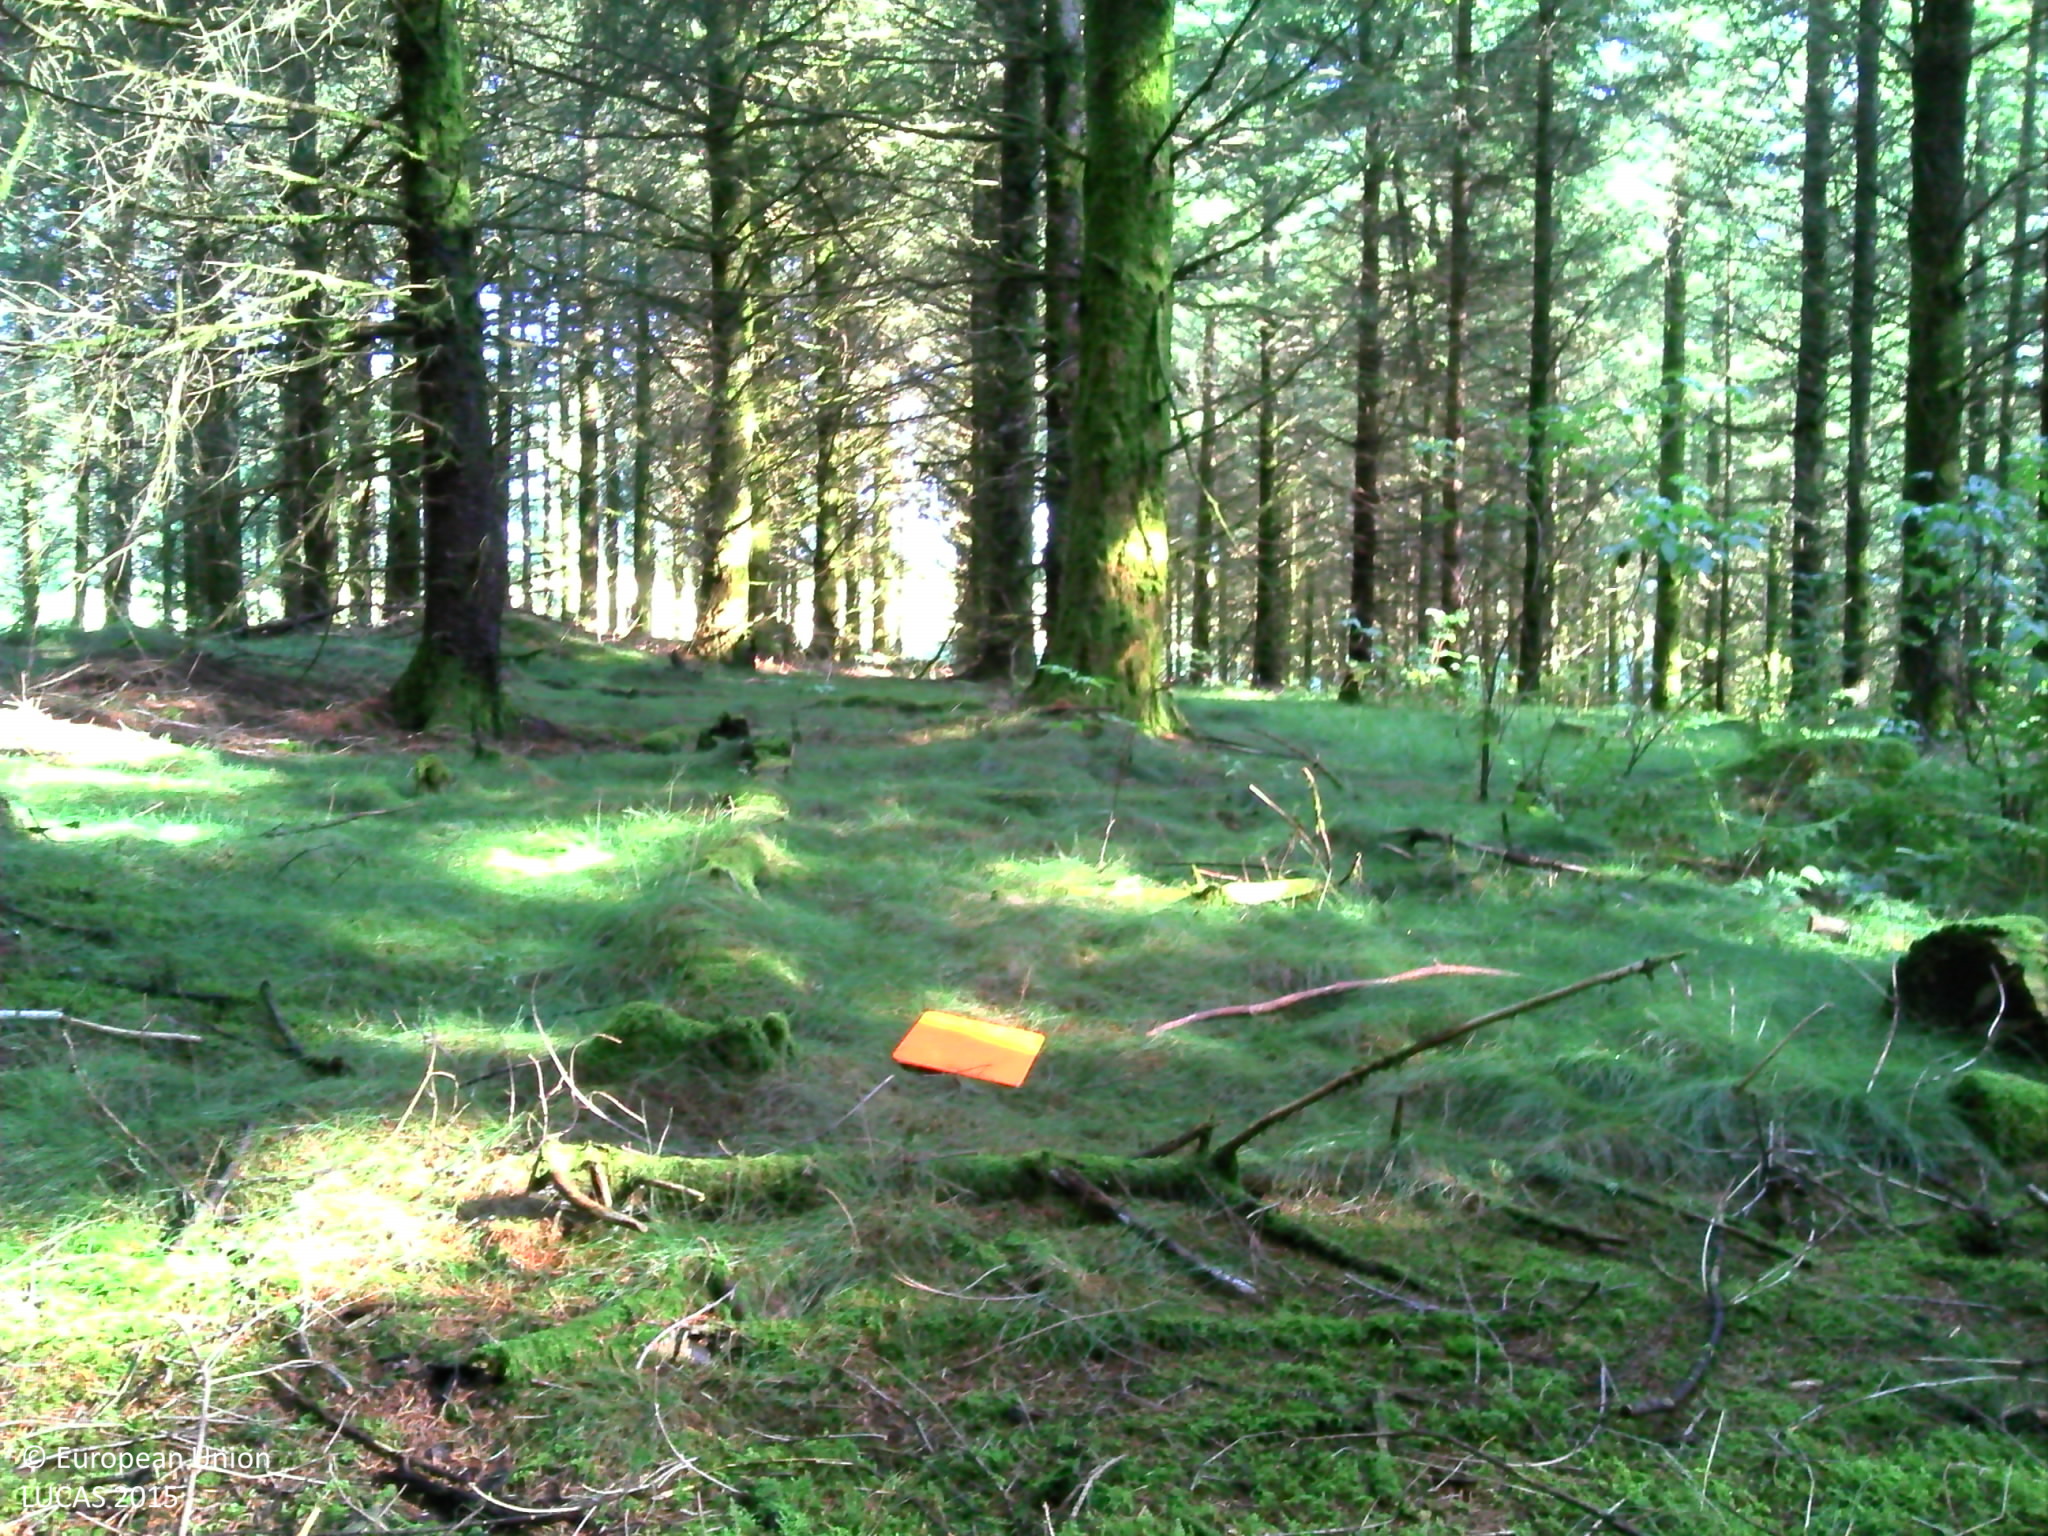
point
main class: Woodland
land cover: Spruce dominated coniferous woodland
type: exotic forest
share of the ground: > 75 %
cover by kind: coniferous forest trees 70 %, herbaceous plants 30 %
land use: Forestry
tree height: > 5 m
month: August
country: FR
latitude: 45.5341
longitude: 1.8640
